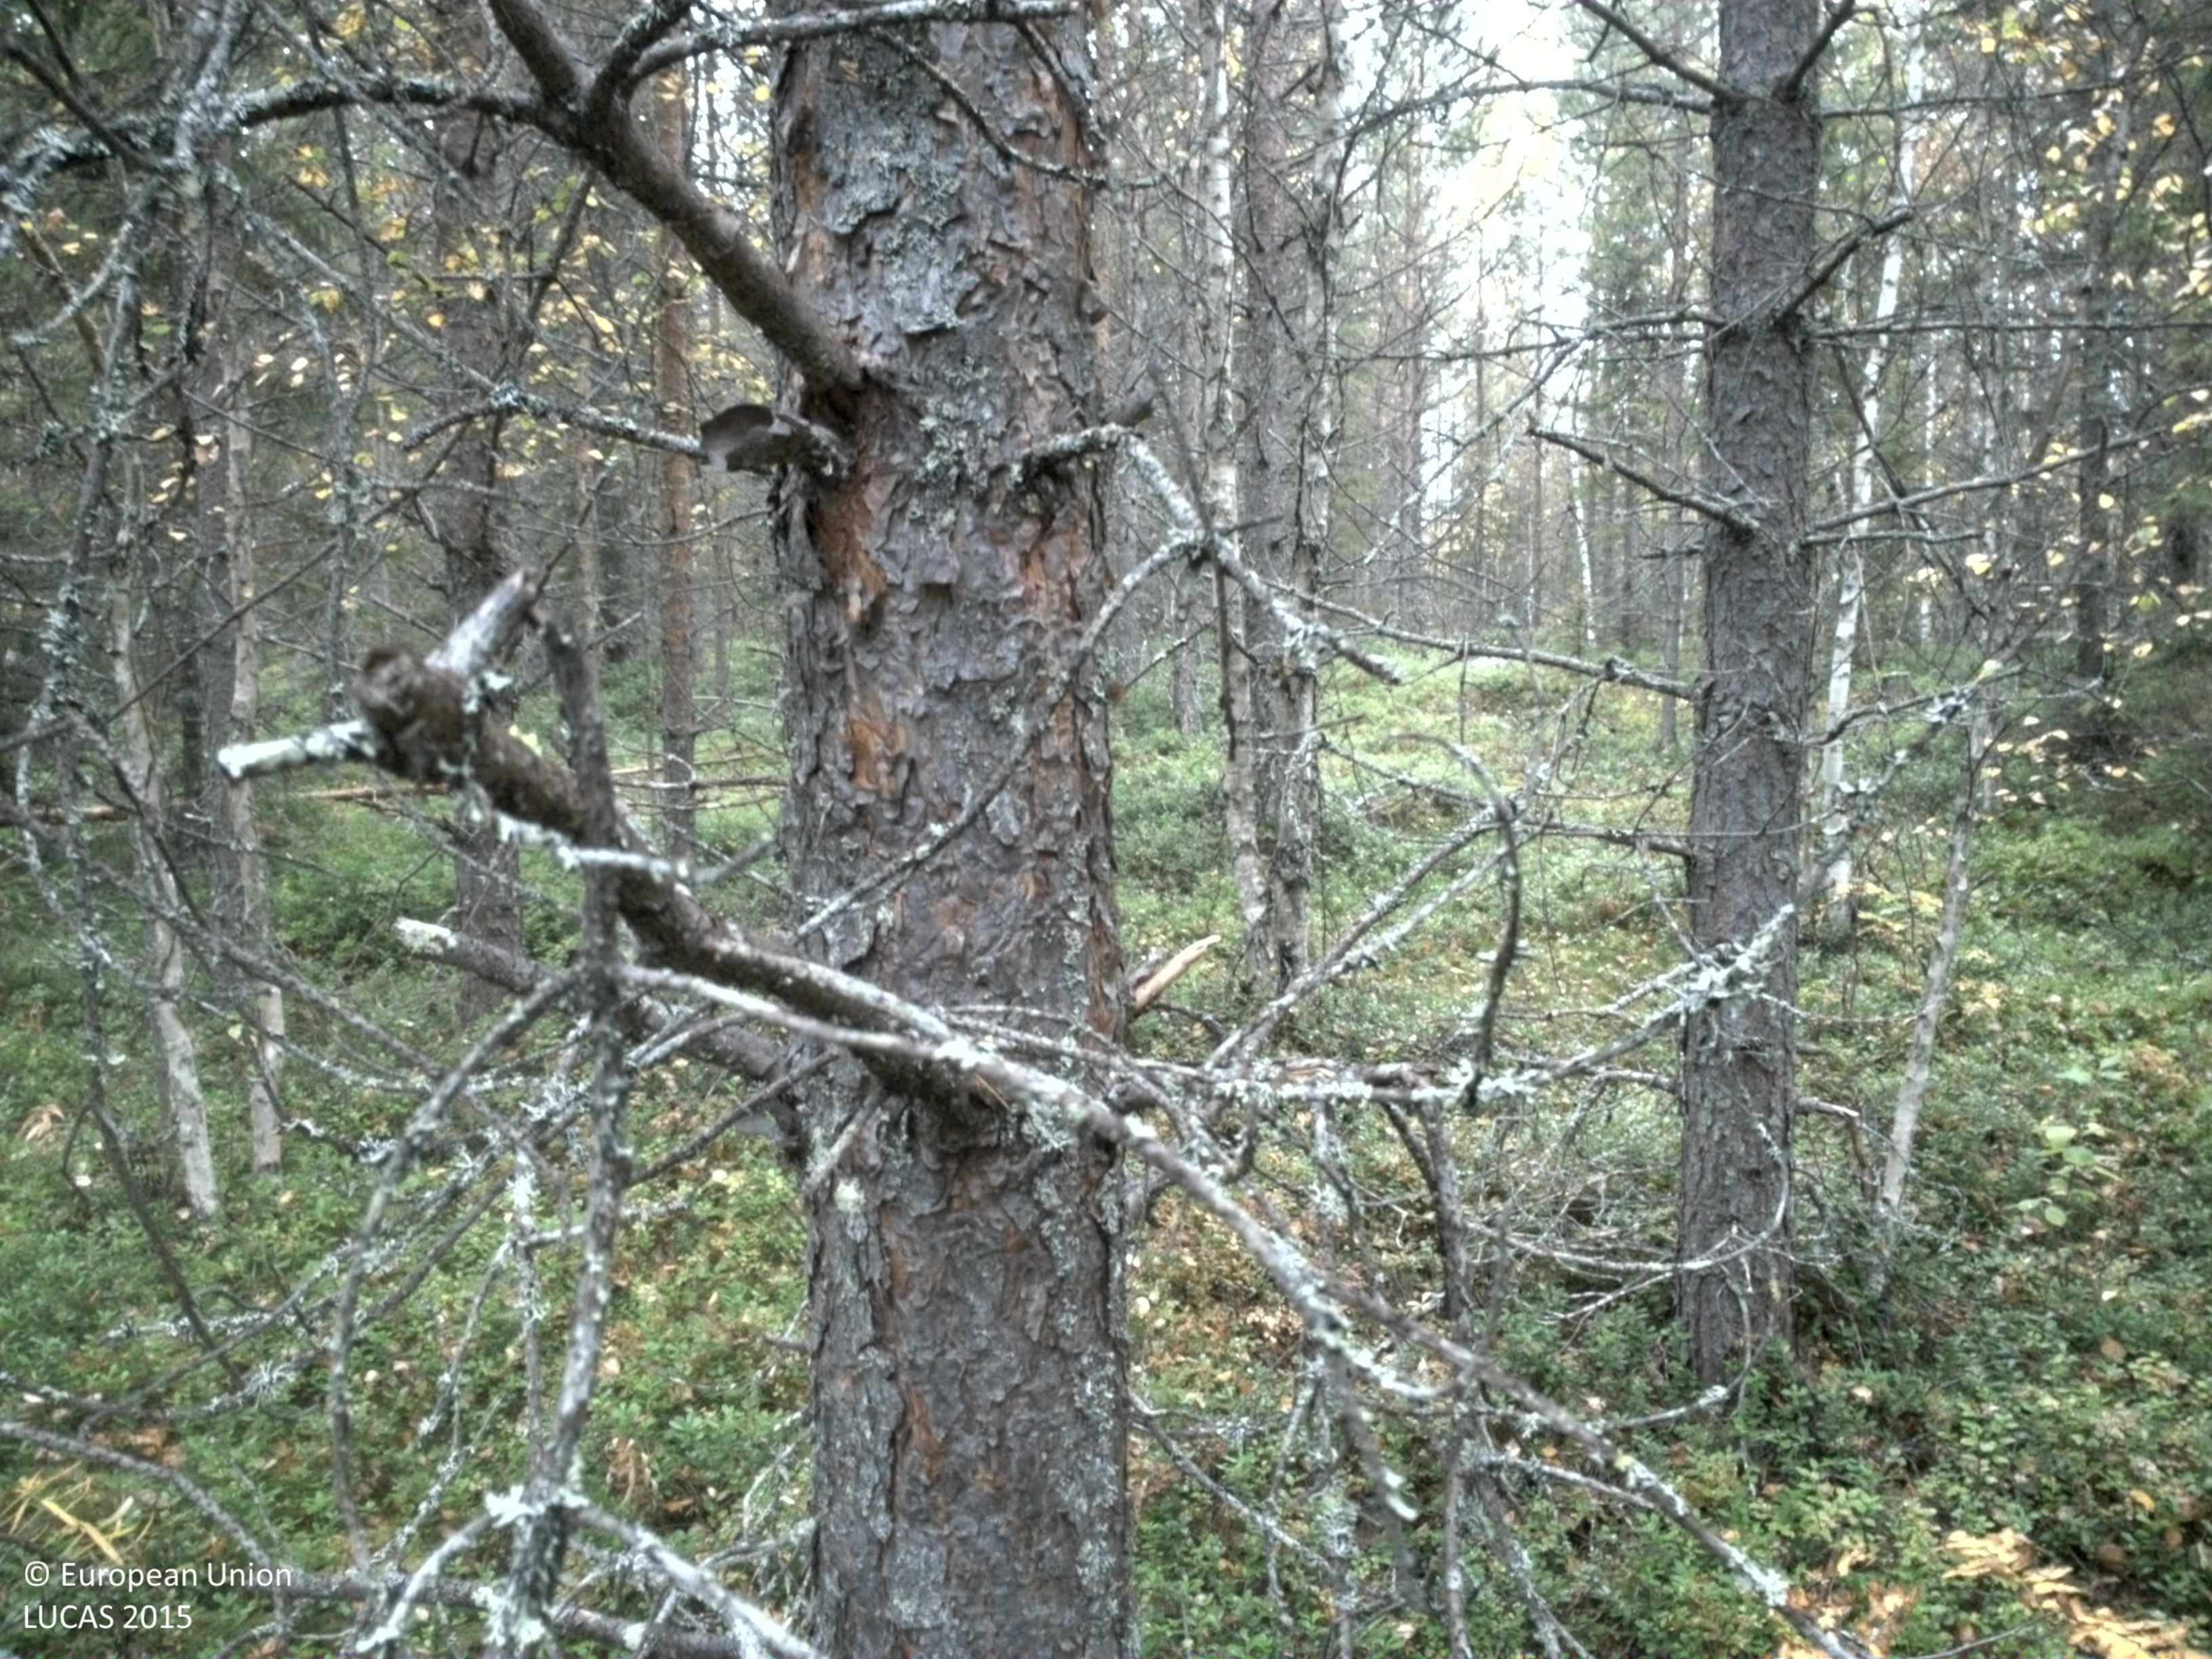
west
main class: Woodland
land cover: Pine dominated coniferous woodland
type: boreal forest
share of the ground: 25 - 50 %
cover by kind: shrubs 50 %, coniferous forest trees 35 %, broadleaved forest trees 10 %, lichens and mosses 5 %
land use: Forestry
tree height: > 5 m
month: September
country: SE
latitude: 65.7990
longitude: 22.1539
